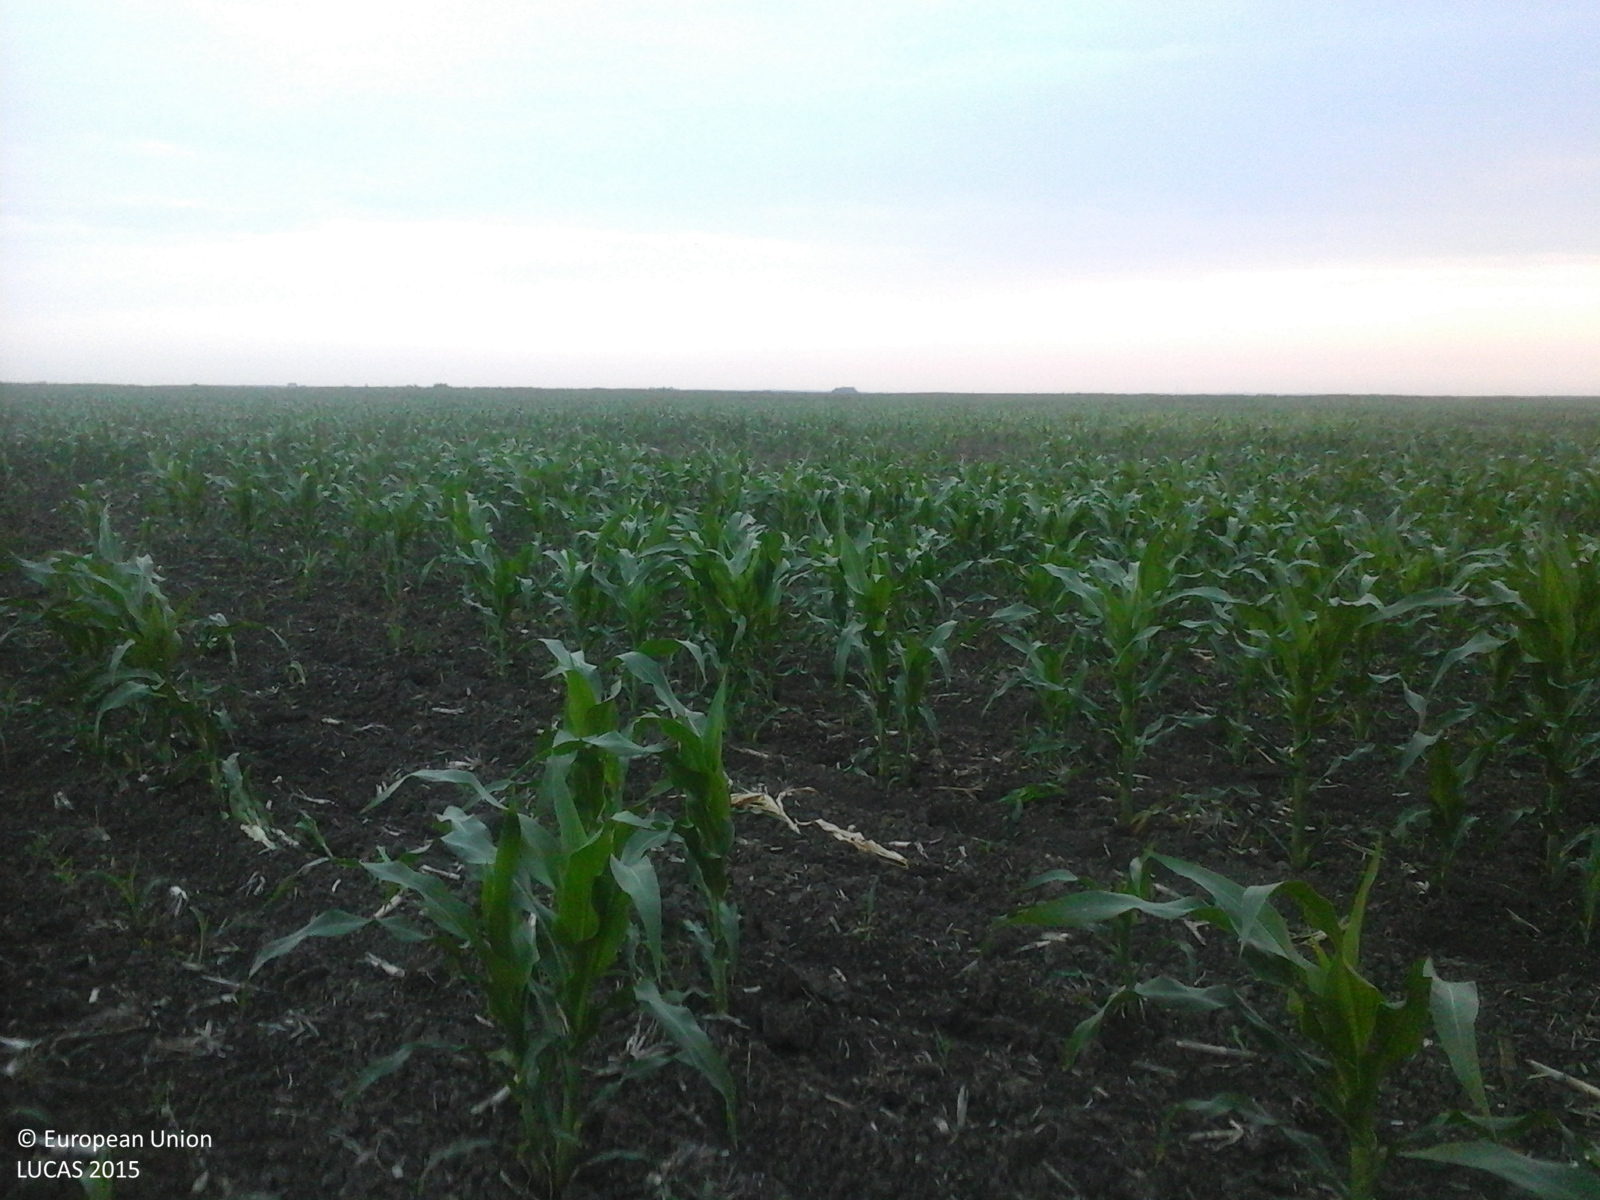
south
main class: Cropland
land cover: Maize
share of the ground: 25 - 50 %
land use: Agriculture (excluding fallow land and kitchen gardens)
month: June
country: RO
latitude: 44.0365
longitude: 26.1111
